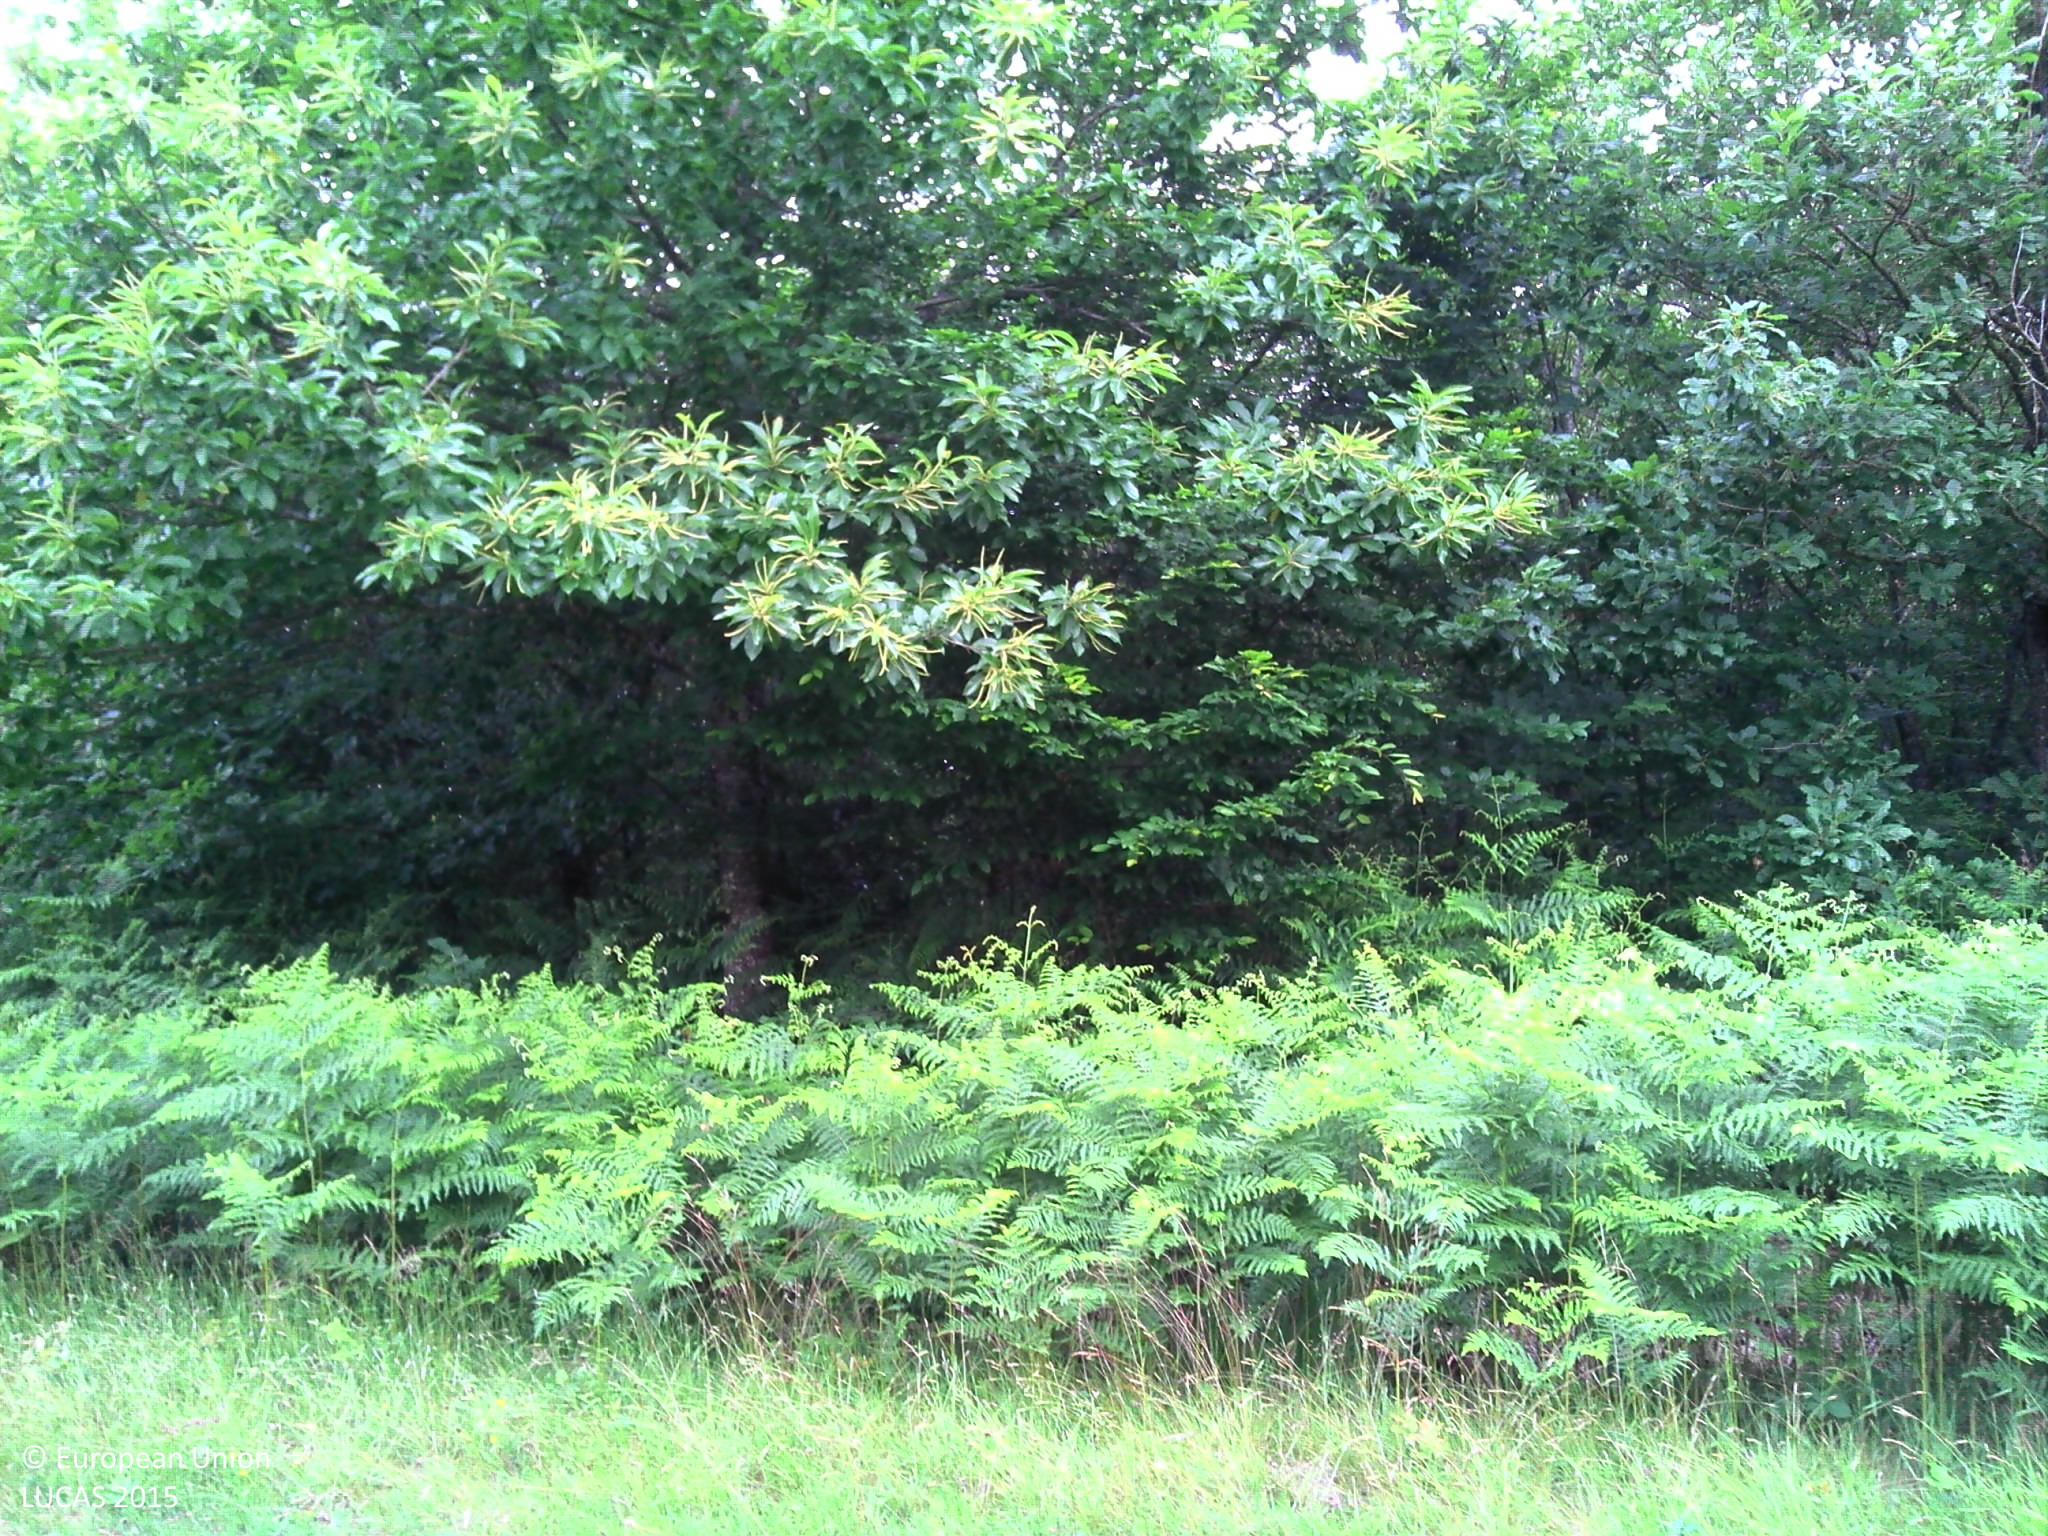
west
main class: Shrubland
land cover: Shrubland with sparse tree cover
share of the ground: > 75 %
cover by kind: shrubs 95 %, broadleaved forest trees 5 %
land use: Forestry
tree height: < 5 m
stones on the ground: < 10 %
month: June
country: FR
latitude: 46.6238
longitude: 2.6688
